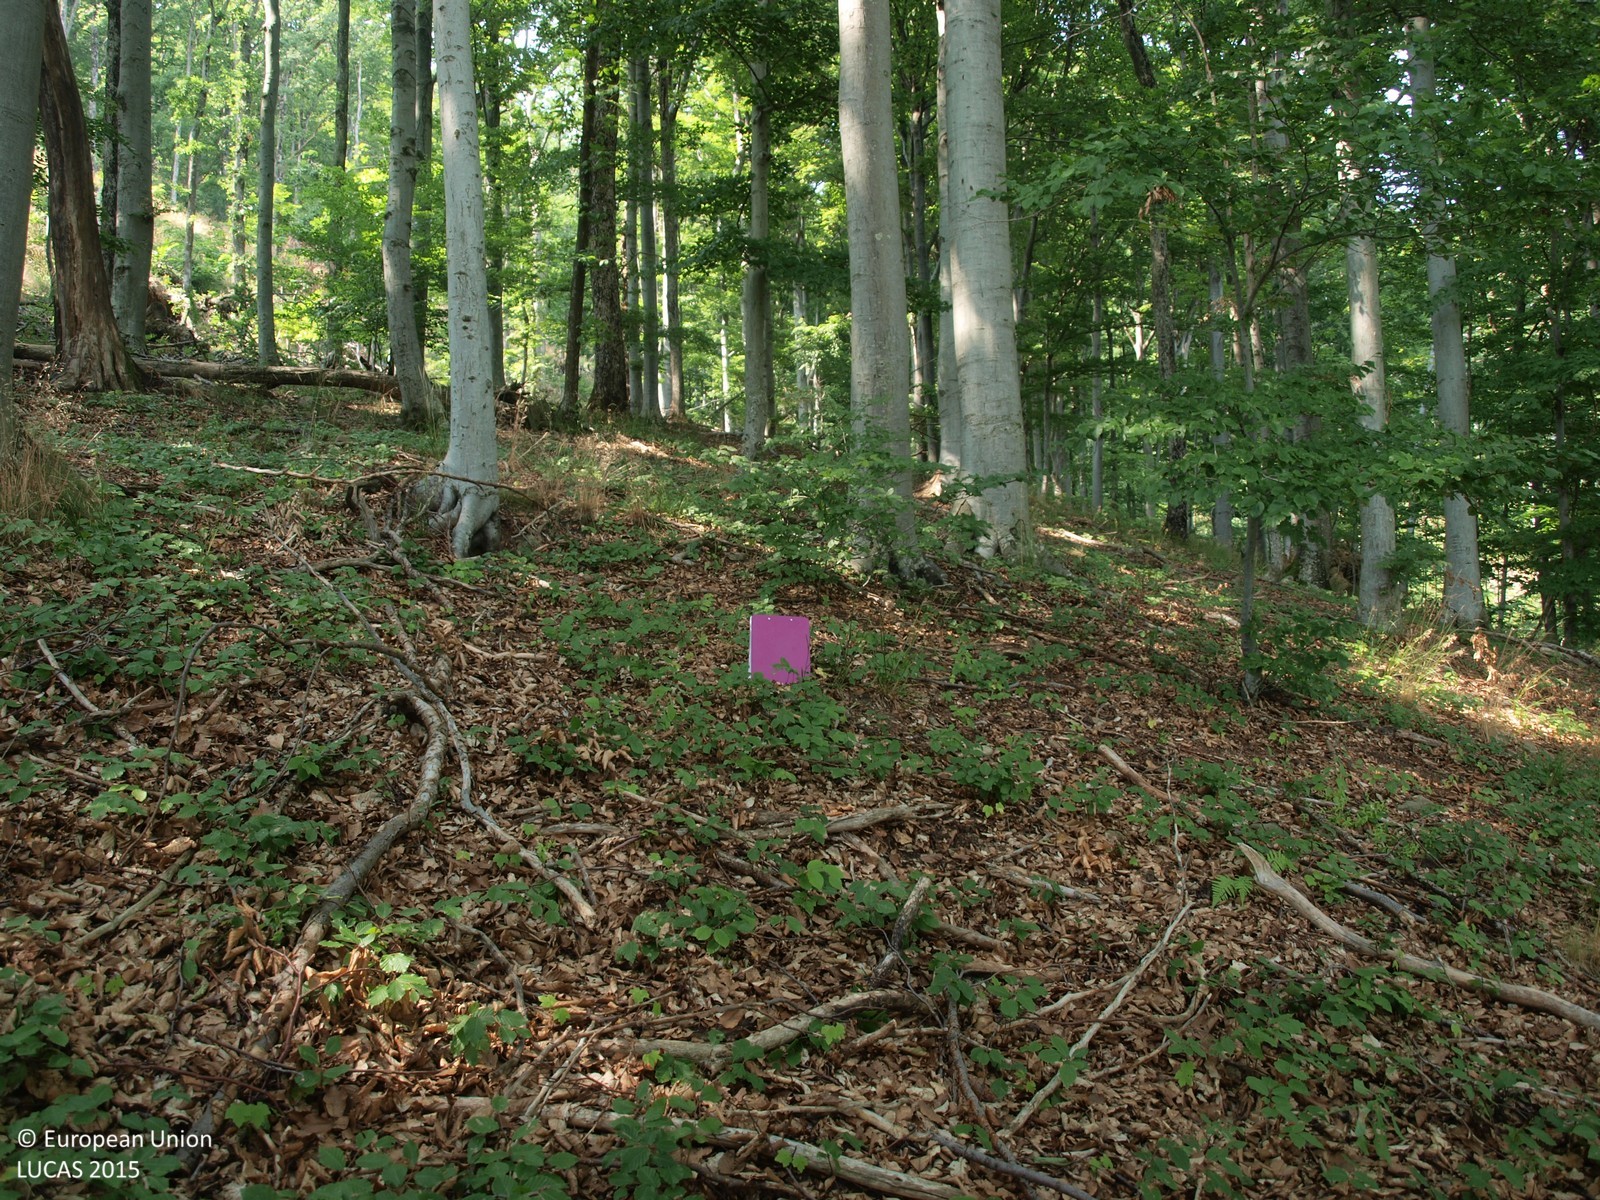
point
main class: Woodland
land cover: Broadleaved woodland
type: beech forest
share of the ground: > 75 %
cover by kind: broadleaved forest trees 100 %
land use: Forestry
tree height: > 5 m
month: August
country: HR
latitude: 45.8792
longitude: 15.9377
